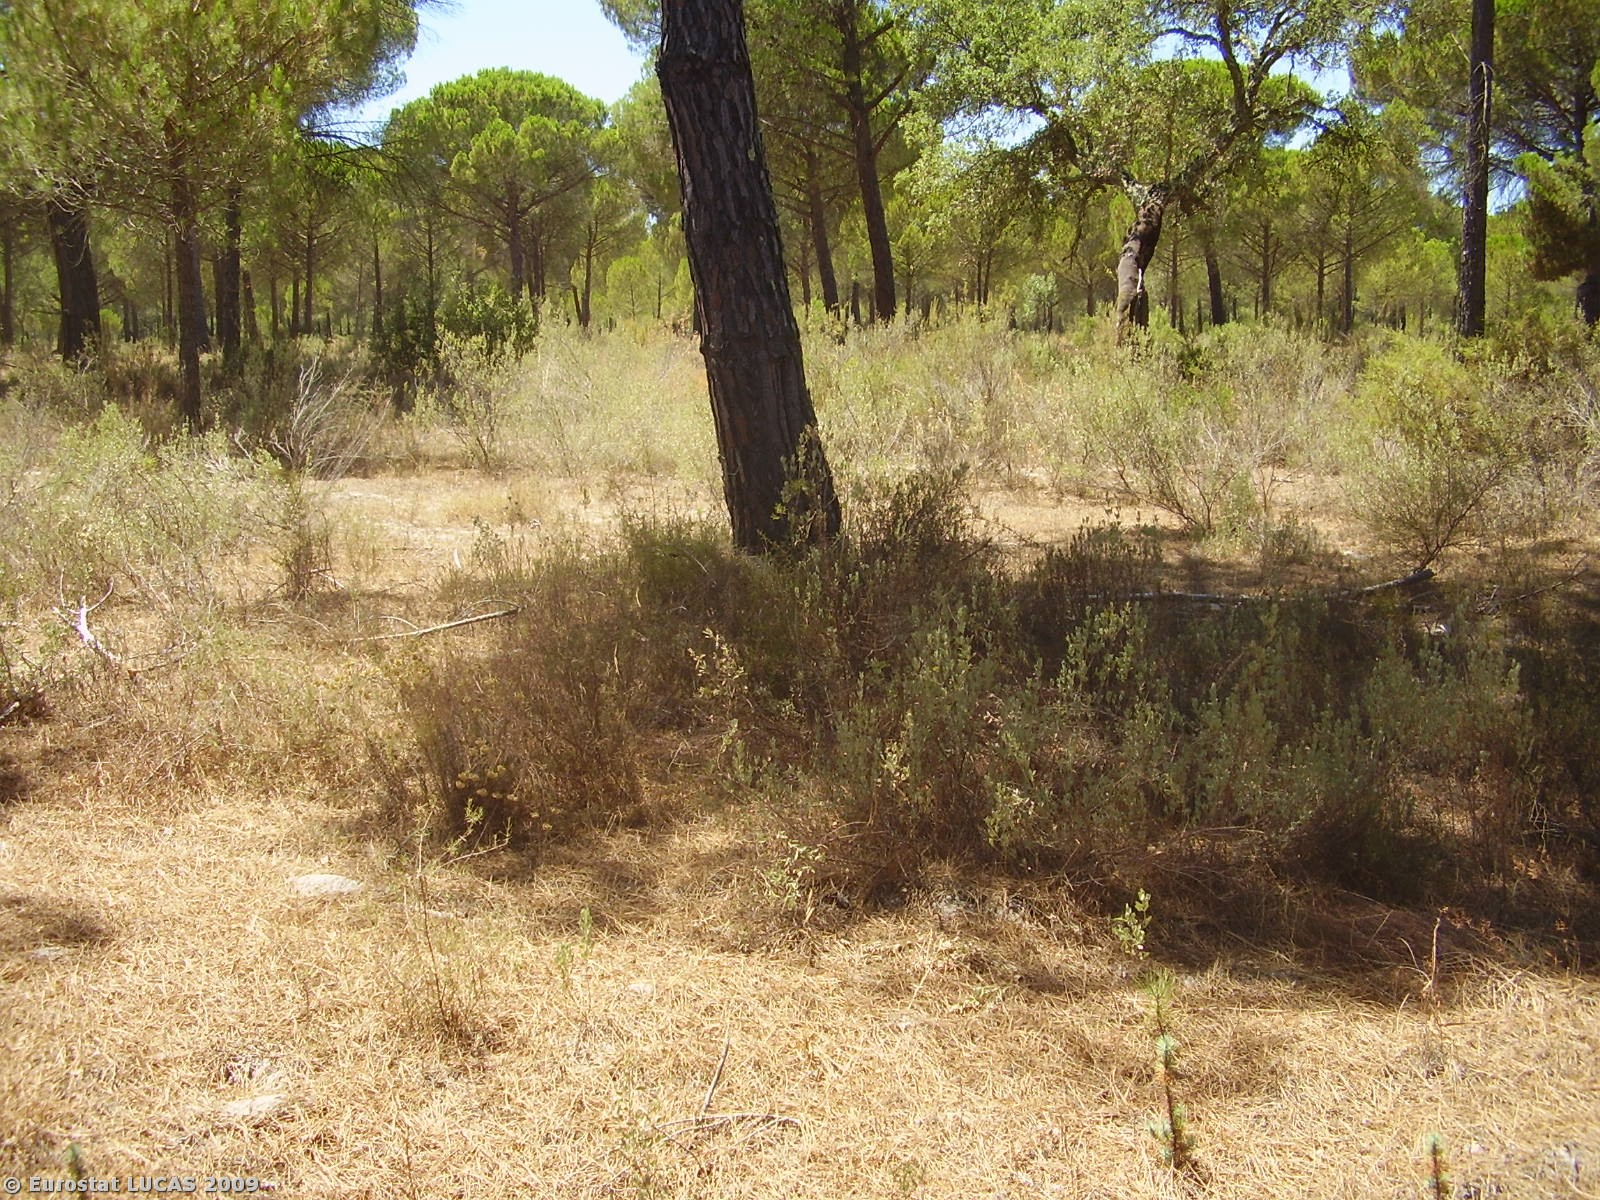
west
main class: Woodland
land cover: Coniferous woodland
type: coniferous forest of the mediterranean region
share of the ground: 10 - 25 %
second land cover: Spontaneously vegetated surfaces
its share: 25 - 50 %
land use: Forestry
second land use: Fallow land
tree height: > 5 m
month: July
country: PT
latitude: 38.1571
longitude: -8.4063
